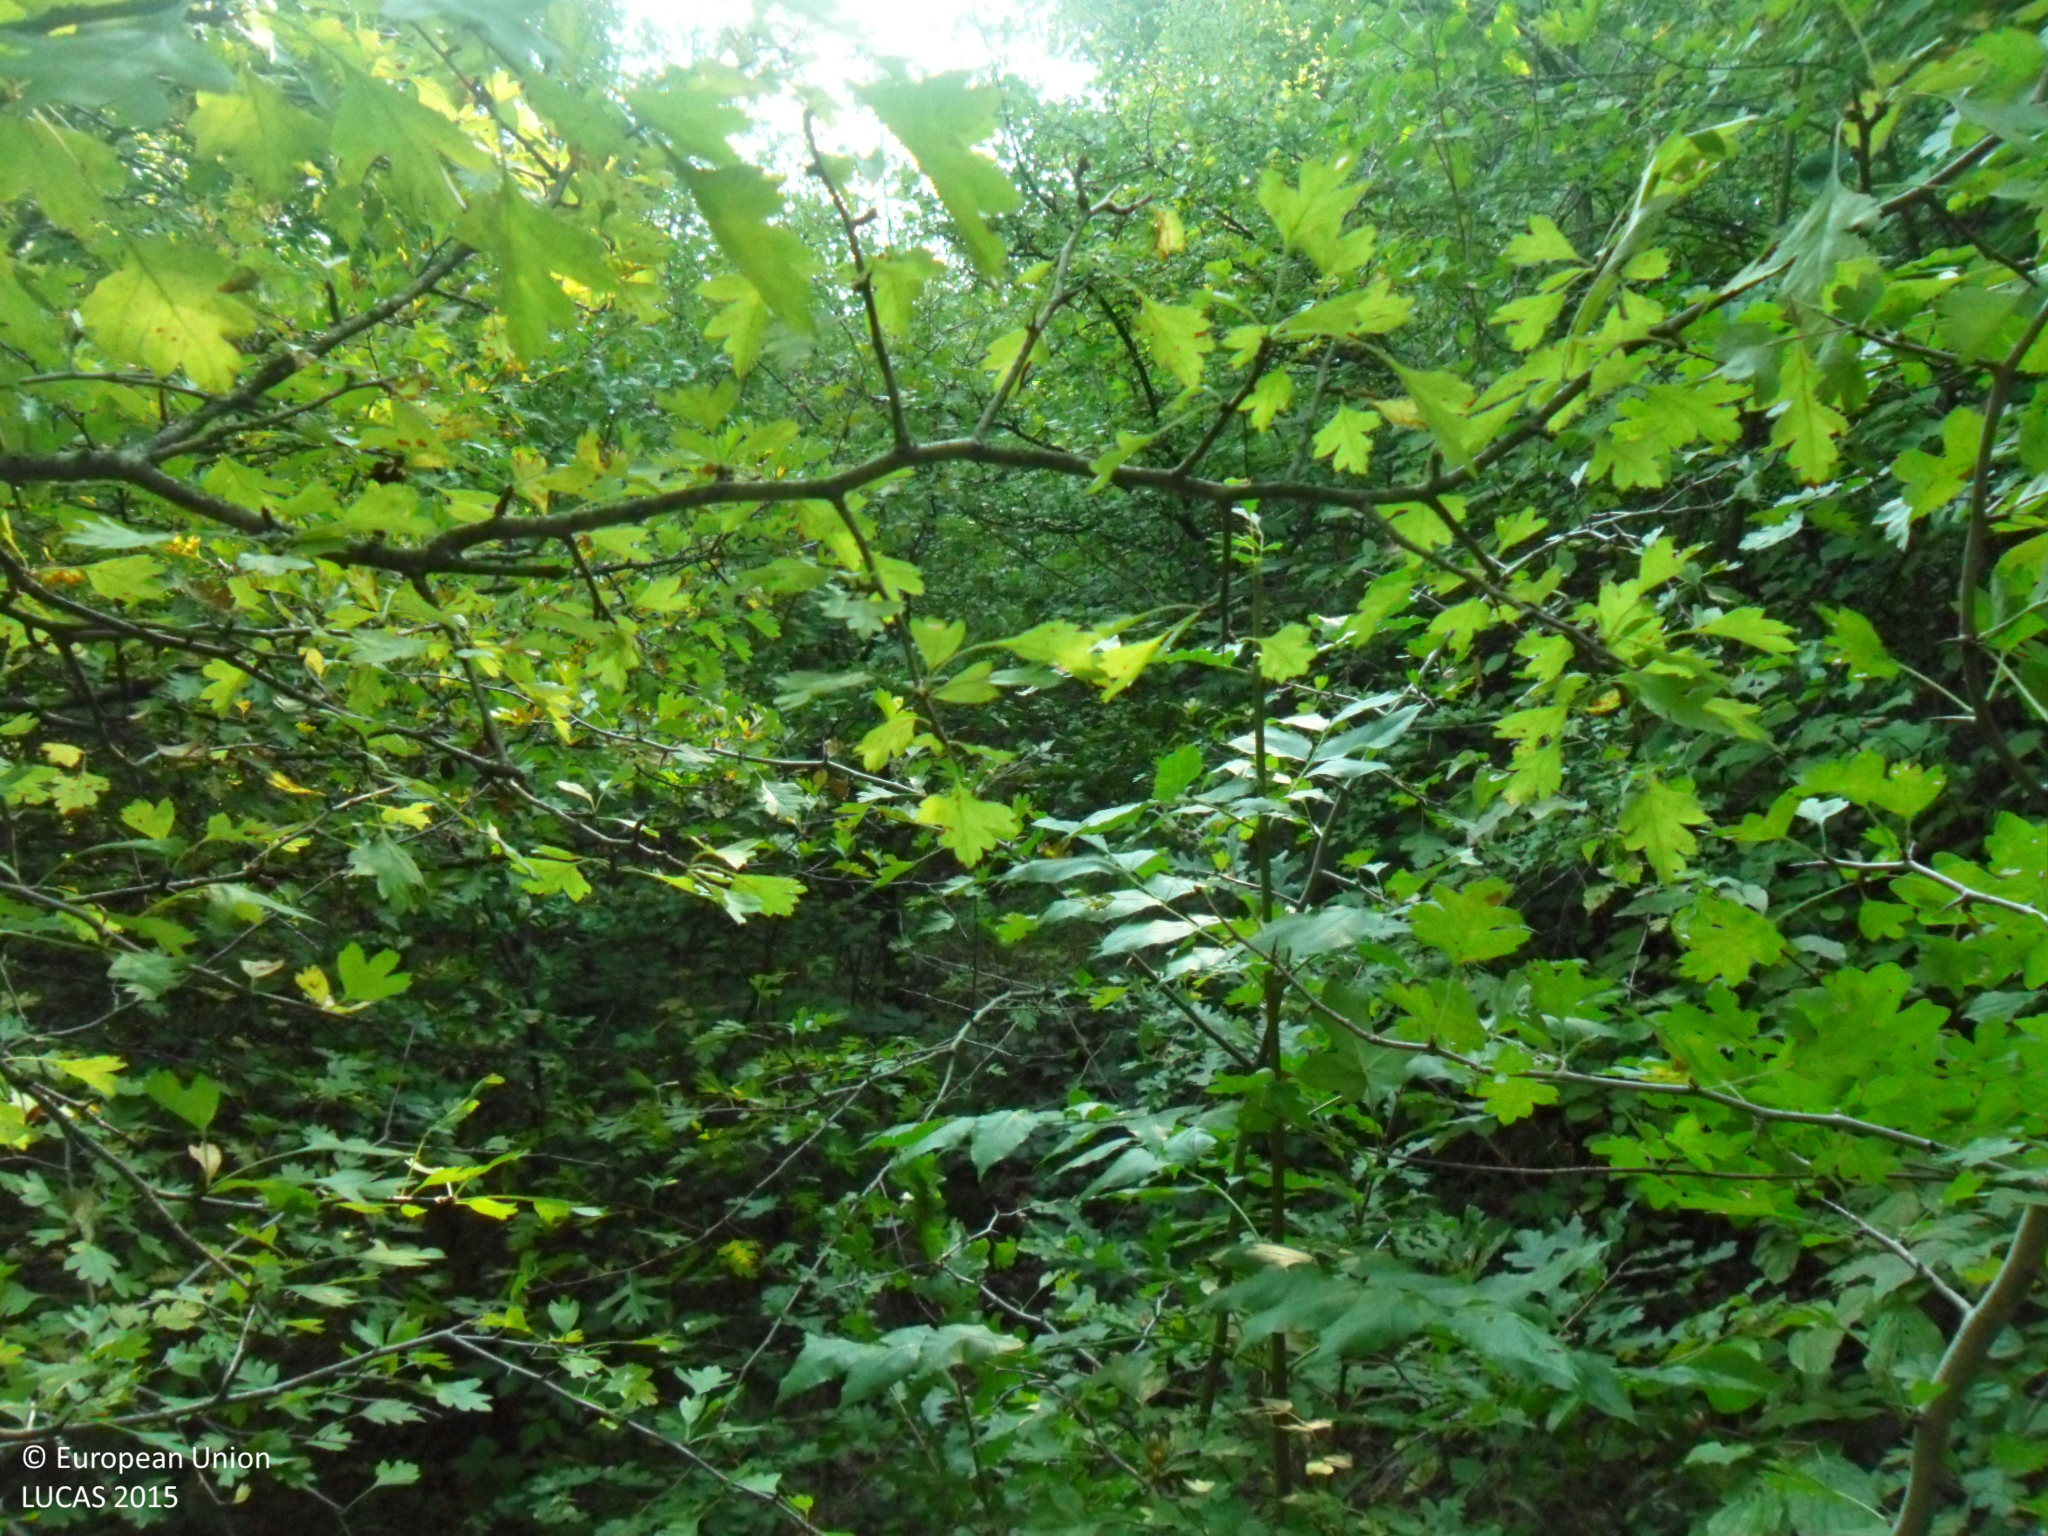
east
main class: Woodland
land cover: Broadleaved woodland
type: mesophytic deciduous forest
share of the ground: 25 - 50 %
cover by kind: shrubs 60 %, broadleaved forest trees 30 %, herbaceous plants 10 %
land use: Forestry
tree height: > 5 m
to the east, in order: Broadleaved woodland; Ditches and canals; Broadleaved woodland; Shrubland without tree cover; Ditches and canals; Shrubland without tree cover
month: September
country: BG
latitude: 43.4838
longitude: 26.6895
